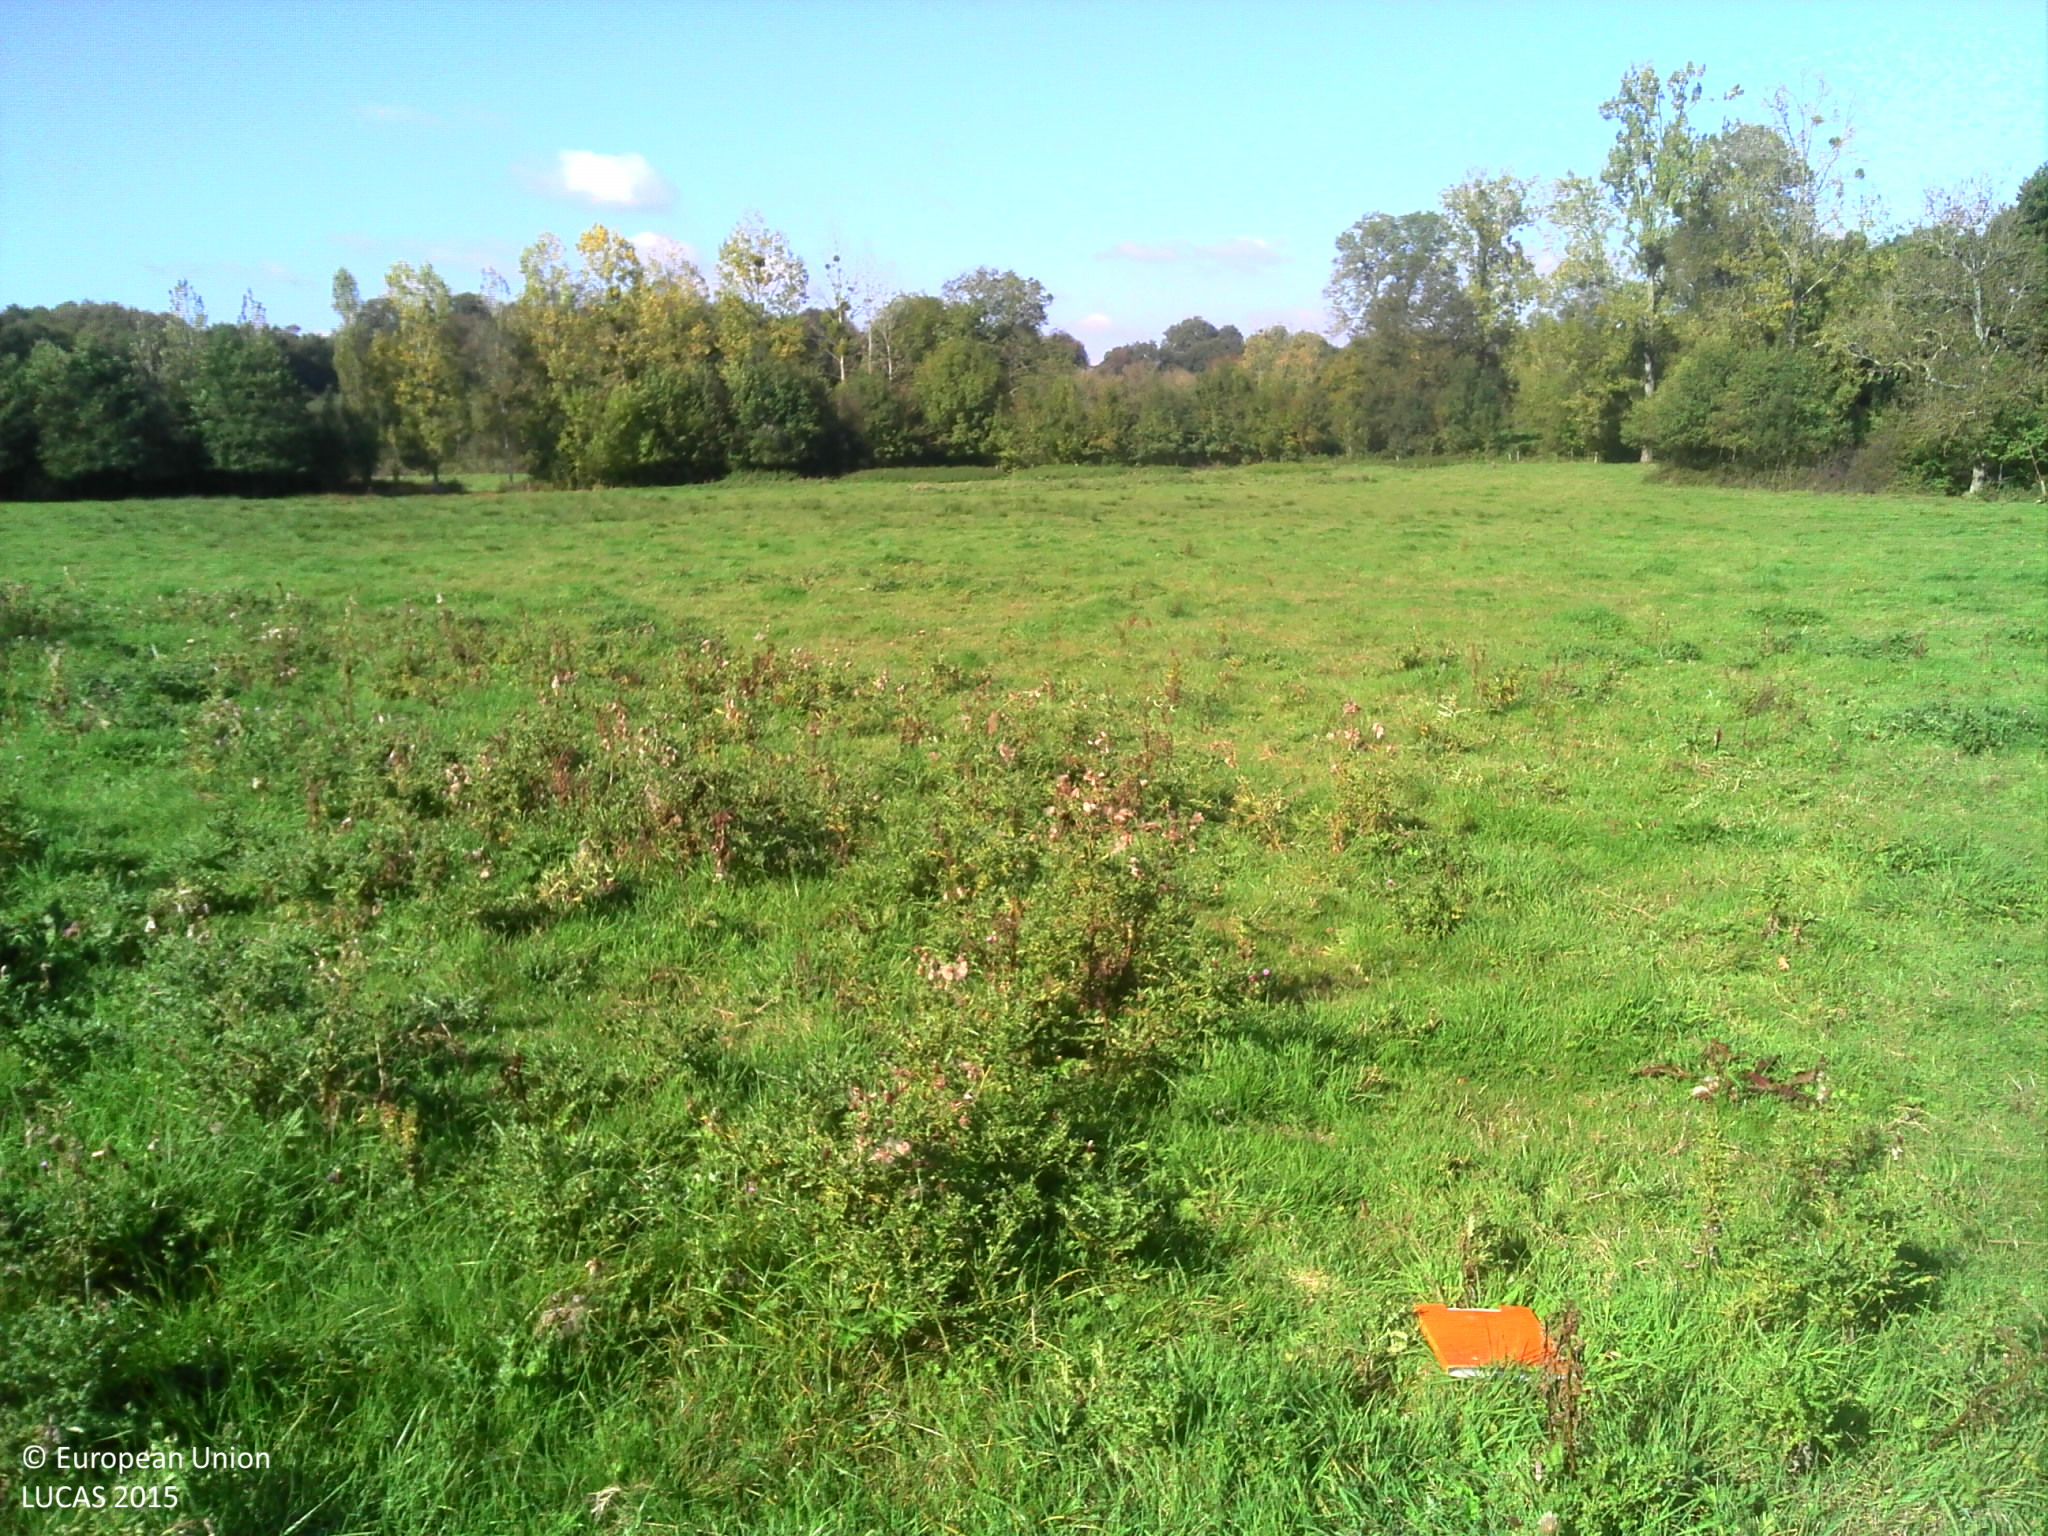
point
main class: Grassland
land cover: Grassland without tree/shrub cover
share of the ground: > 75 %
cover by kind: herbaceous plants 100 %
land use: Agriculture (excluding fallow land and kitchen gardens)
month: October
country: FR
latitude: 46.8421
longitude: -1.4602
